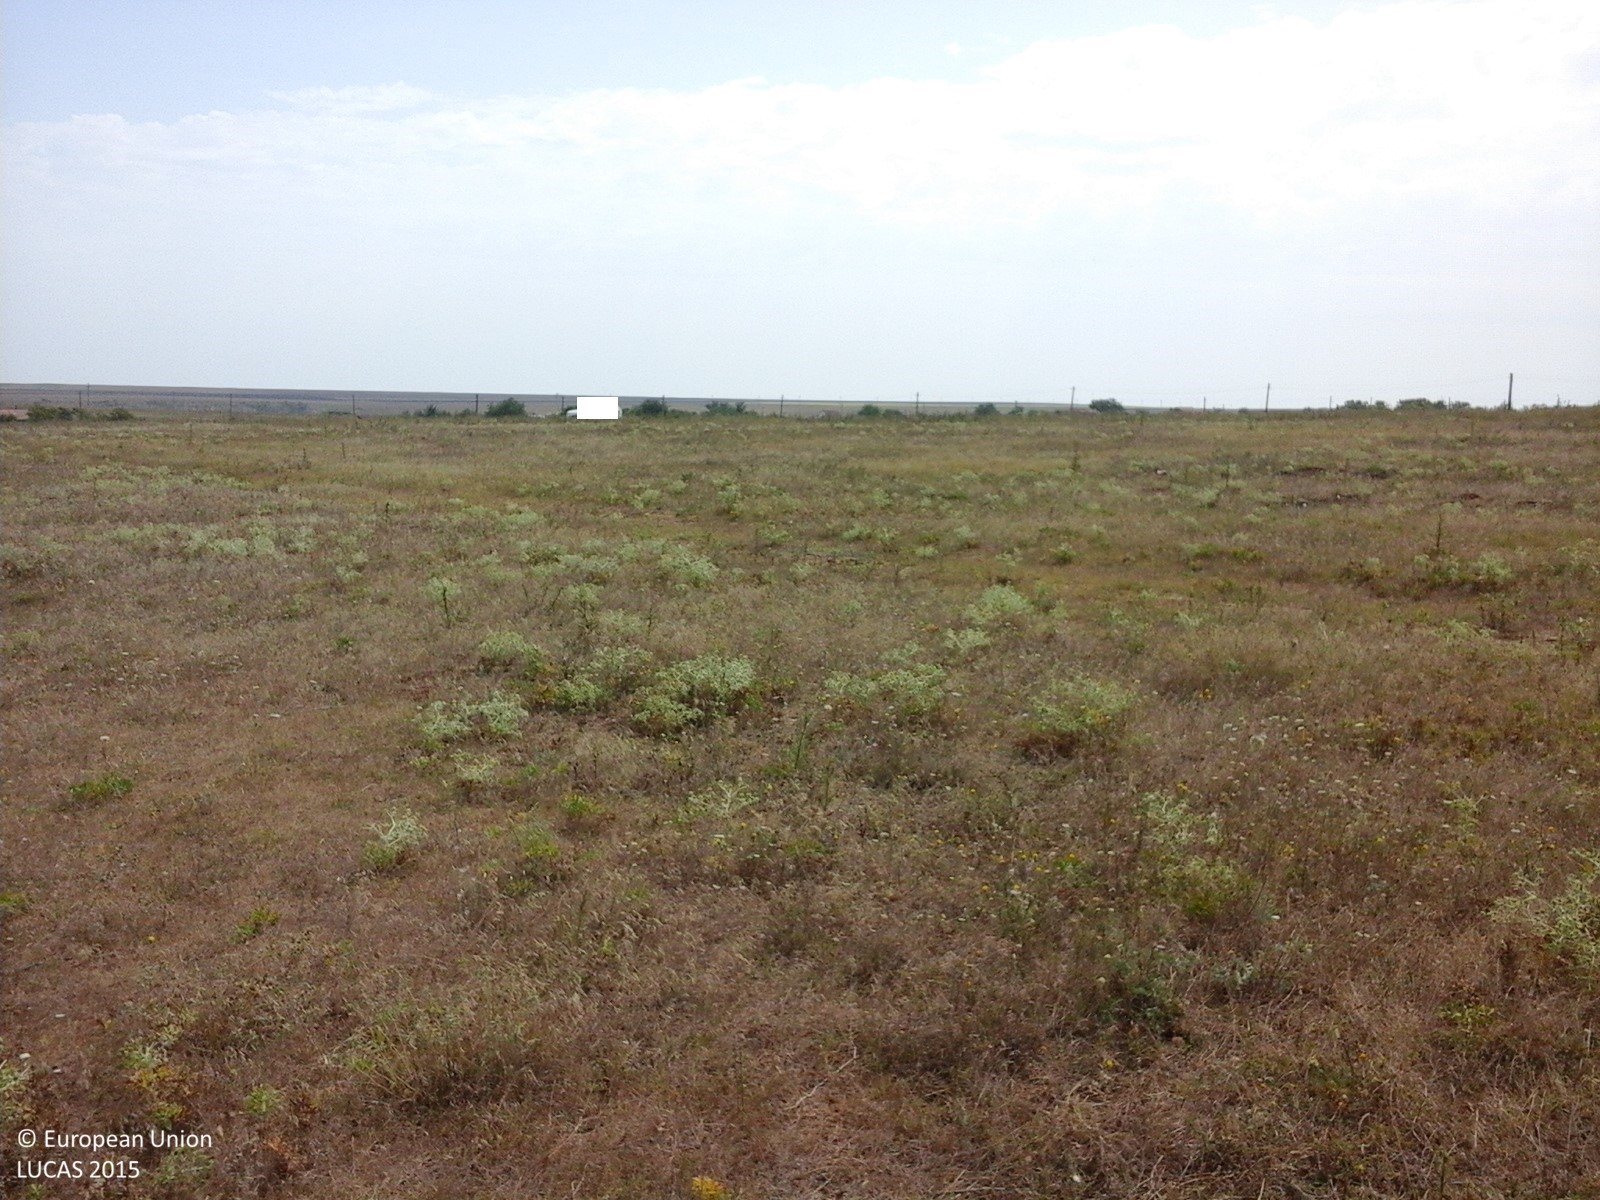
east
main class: Grassland
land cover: Spontaneously vegetated surfaces
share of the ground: > 75 %
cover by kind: herbaceous plants 100 %
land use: Fallow land
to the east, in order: Spontaneously vegetated surfaces; Tracks; Spontaneously vegetated surfaces; Ditches and canals; Spontaneously vegetated surfaces; Paved roads, cycling and walking lanes; Spontaneously vegetated surfaces; Tracks; Spontaneously vegetated surfaces; Tracks
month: August
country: RO
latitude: 43.7879
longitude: 28.3400
